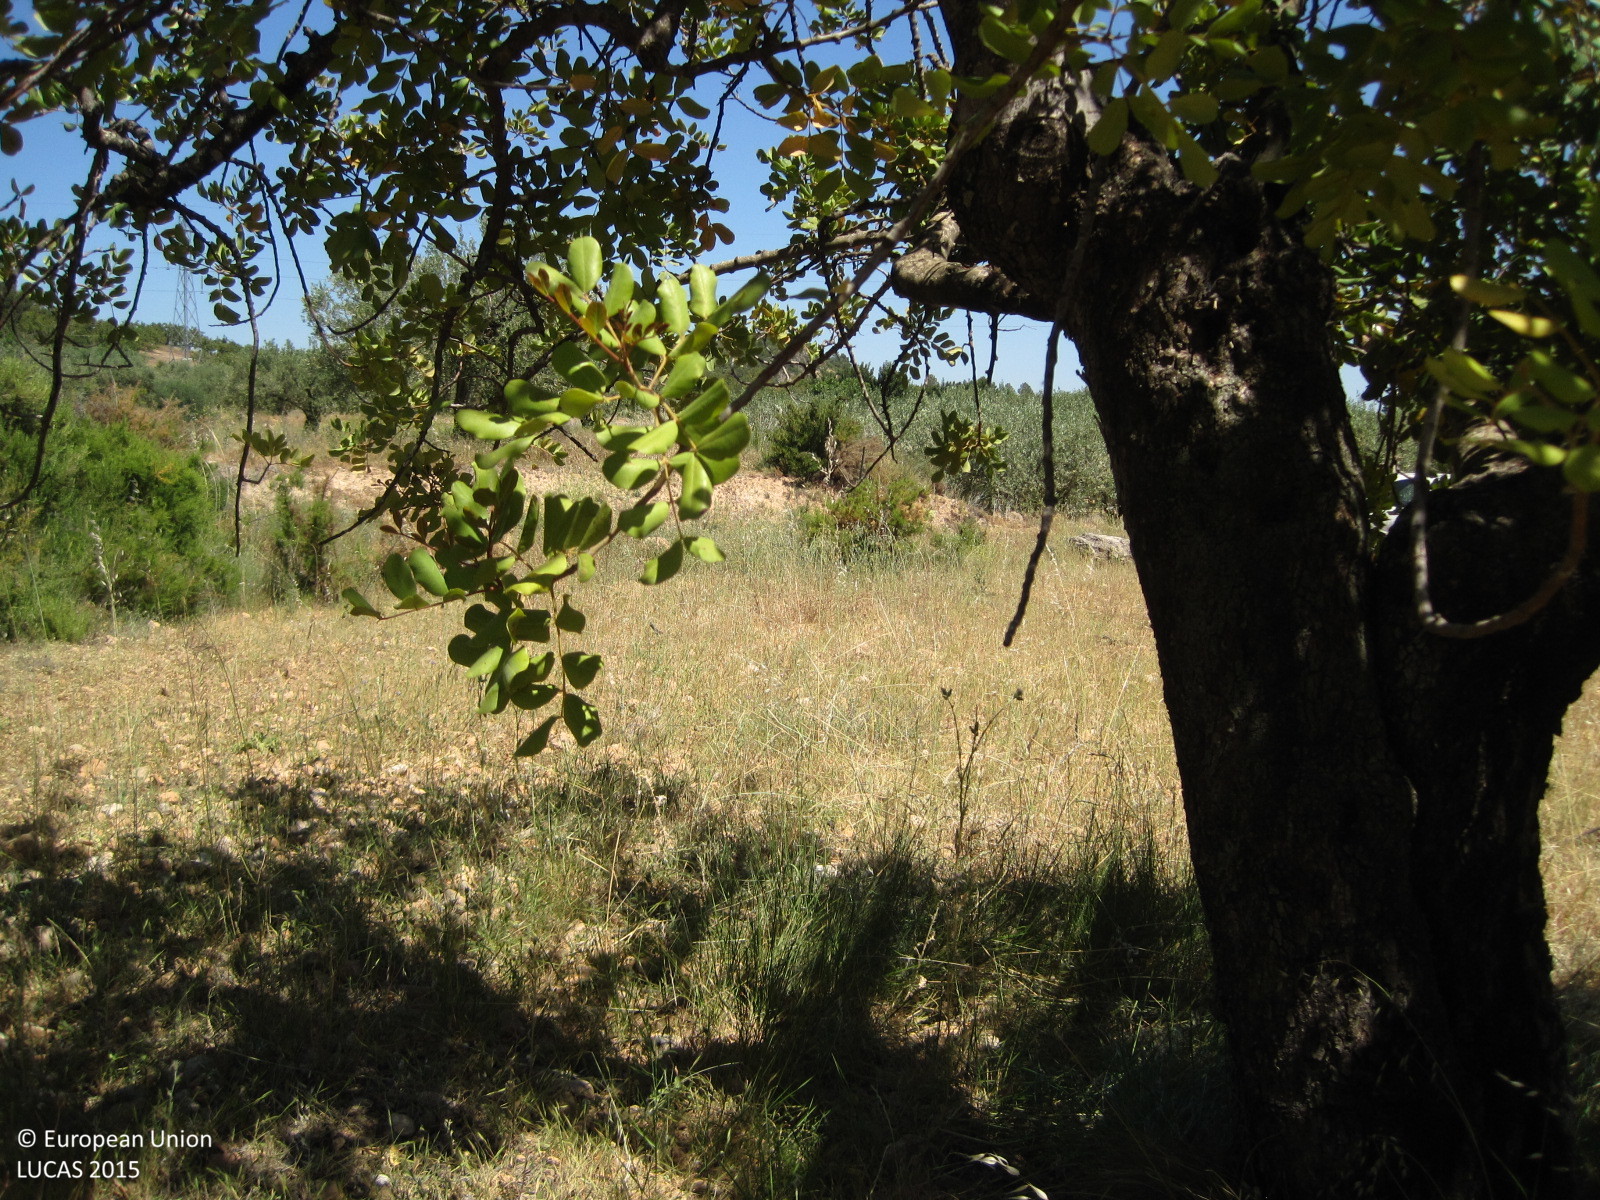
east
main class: Cropland
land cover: Permanent industrial crops
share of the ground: 10 - 25 %
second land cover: Spontaneously vegetated surfaces
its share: > 75 %
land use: Agriculture (excluding fallow land and kitchen gardens)
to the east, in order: Permanent industrial crops; Spontaneously vegetated surfaces; Grass margins; Tracks; Grass margins; Olive groves; Grassland without tree/shrub cover; Electric lines; Grassland without tree/shrub cover; Vineyards; Spontaneously vegetated surfaces; Ditches and canals; Other fruit trees and berries; Tracks; Grass margins; Ditches and canals; Olive groves
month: May
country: ES
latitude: 39.3768
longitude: -0.8059
